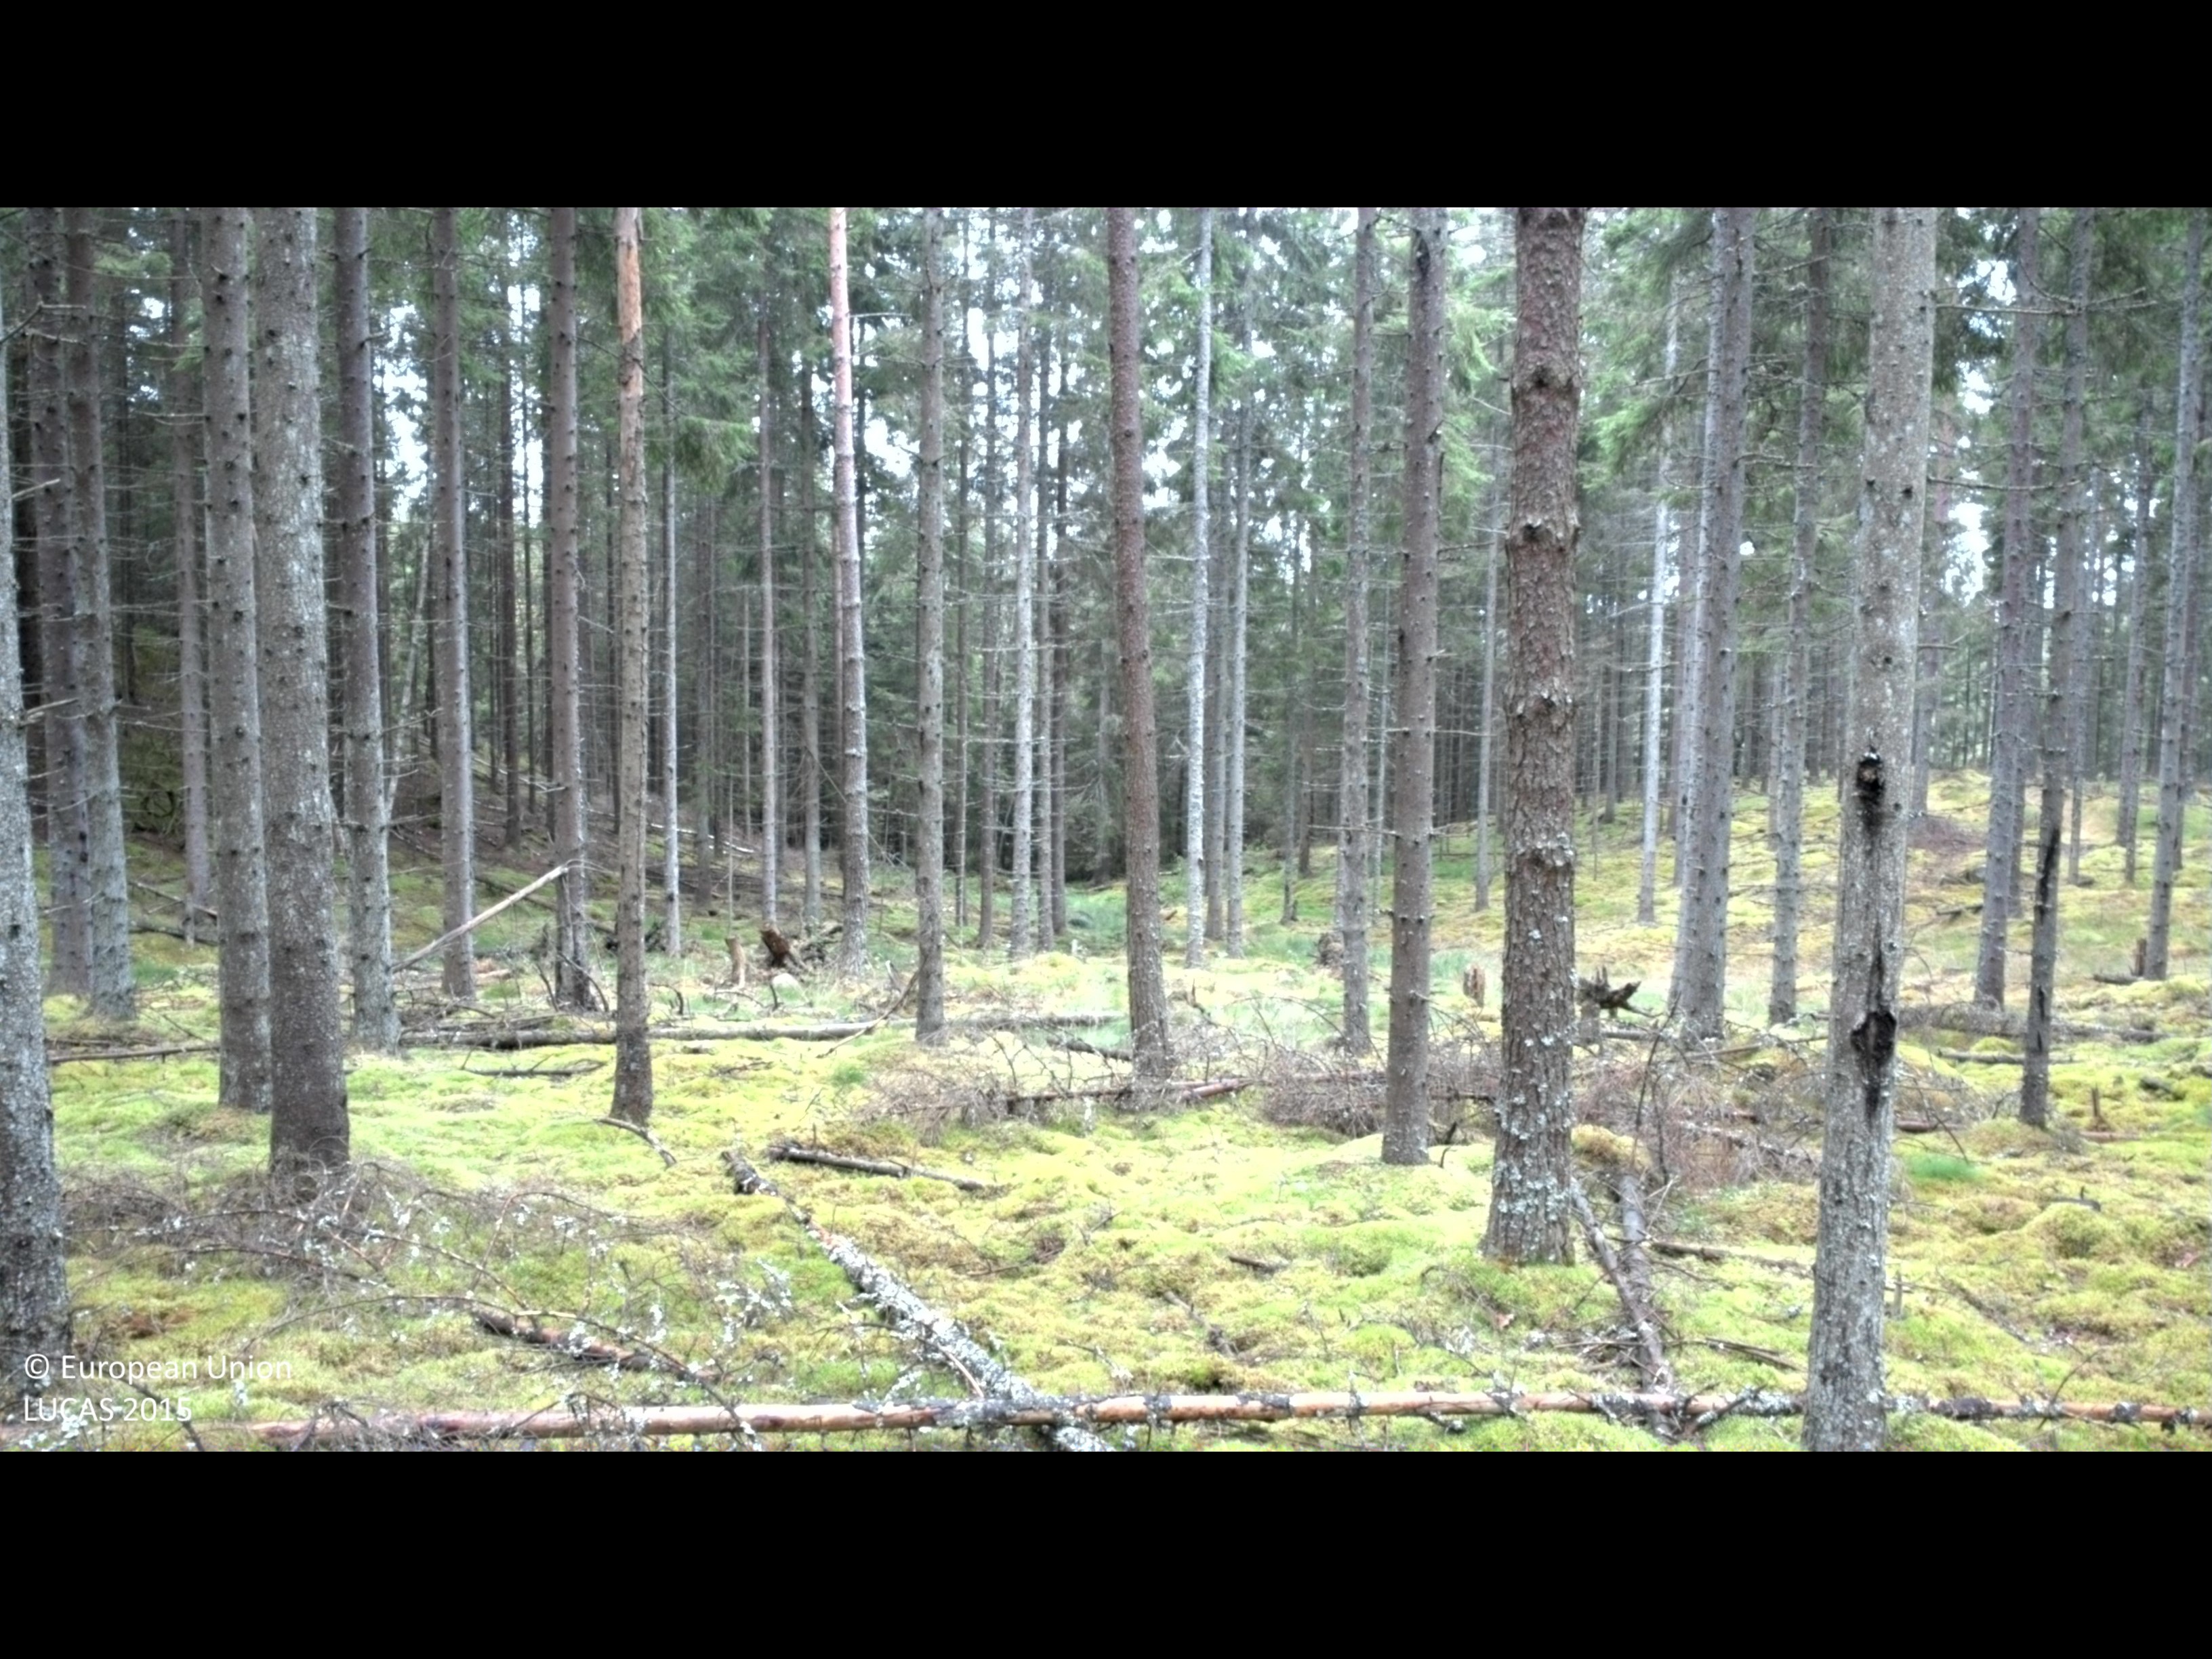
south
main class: Woodland
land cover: Spruce dominated coniferous woodland
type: boreal forest
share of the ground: 50 - 75 %
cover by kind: coniferous forest trees 75 %, lichens and mosses 25 %
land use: Forestry
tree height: > 5 m
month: August
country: SE
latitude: 57.3007
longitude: 13.8297
